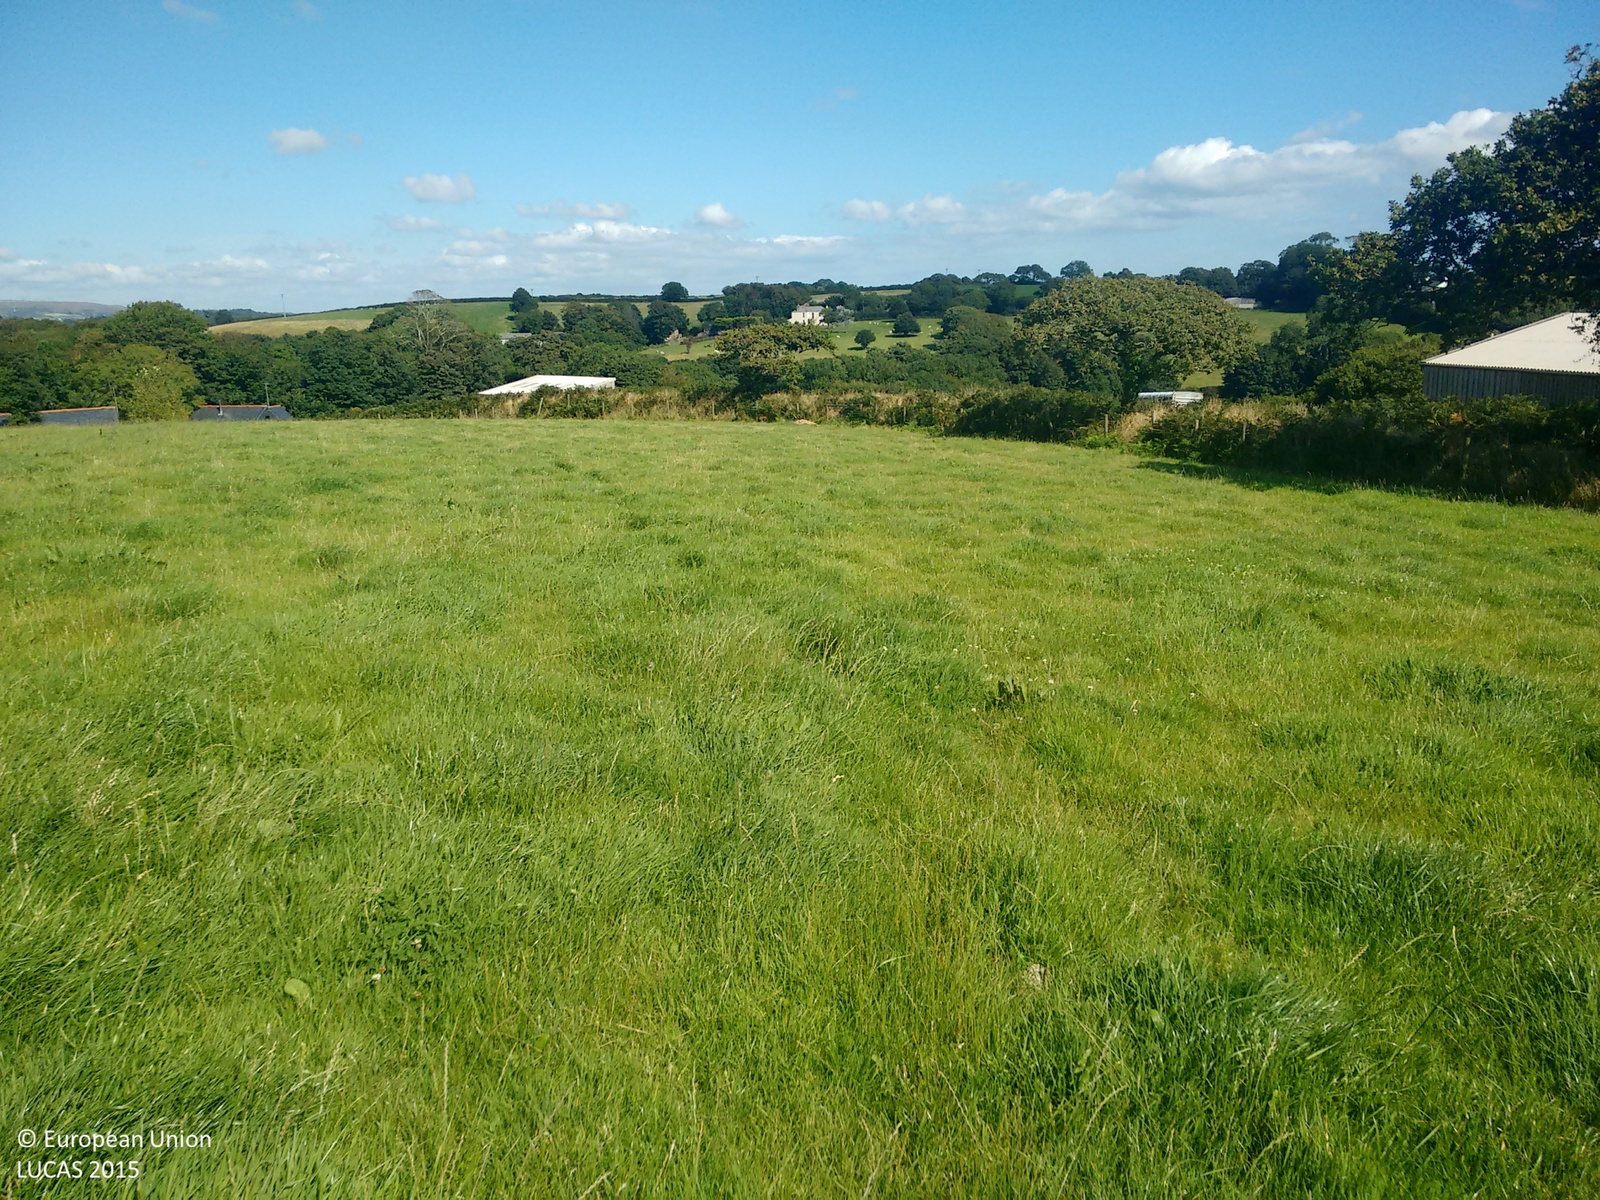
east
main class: Grassland
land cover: Grassland without tree/shrub cover
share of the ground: > 75 %
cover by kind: herbaceous plants 100 %
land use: Agriculture (excluding fallow land and kitchen gardens)
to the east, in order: Grassland without tree/shrub cover; Fences; Abandoned hedges; Tracks; Managed hedges; Fences; Grassland without tree/shrub cover; Fences; Shrubland with sparse tree cover; Railways; Broadleaved woodland
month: August
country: GB
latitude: 50.3064
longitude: -4.9557
